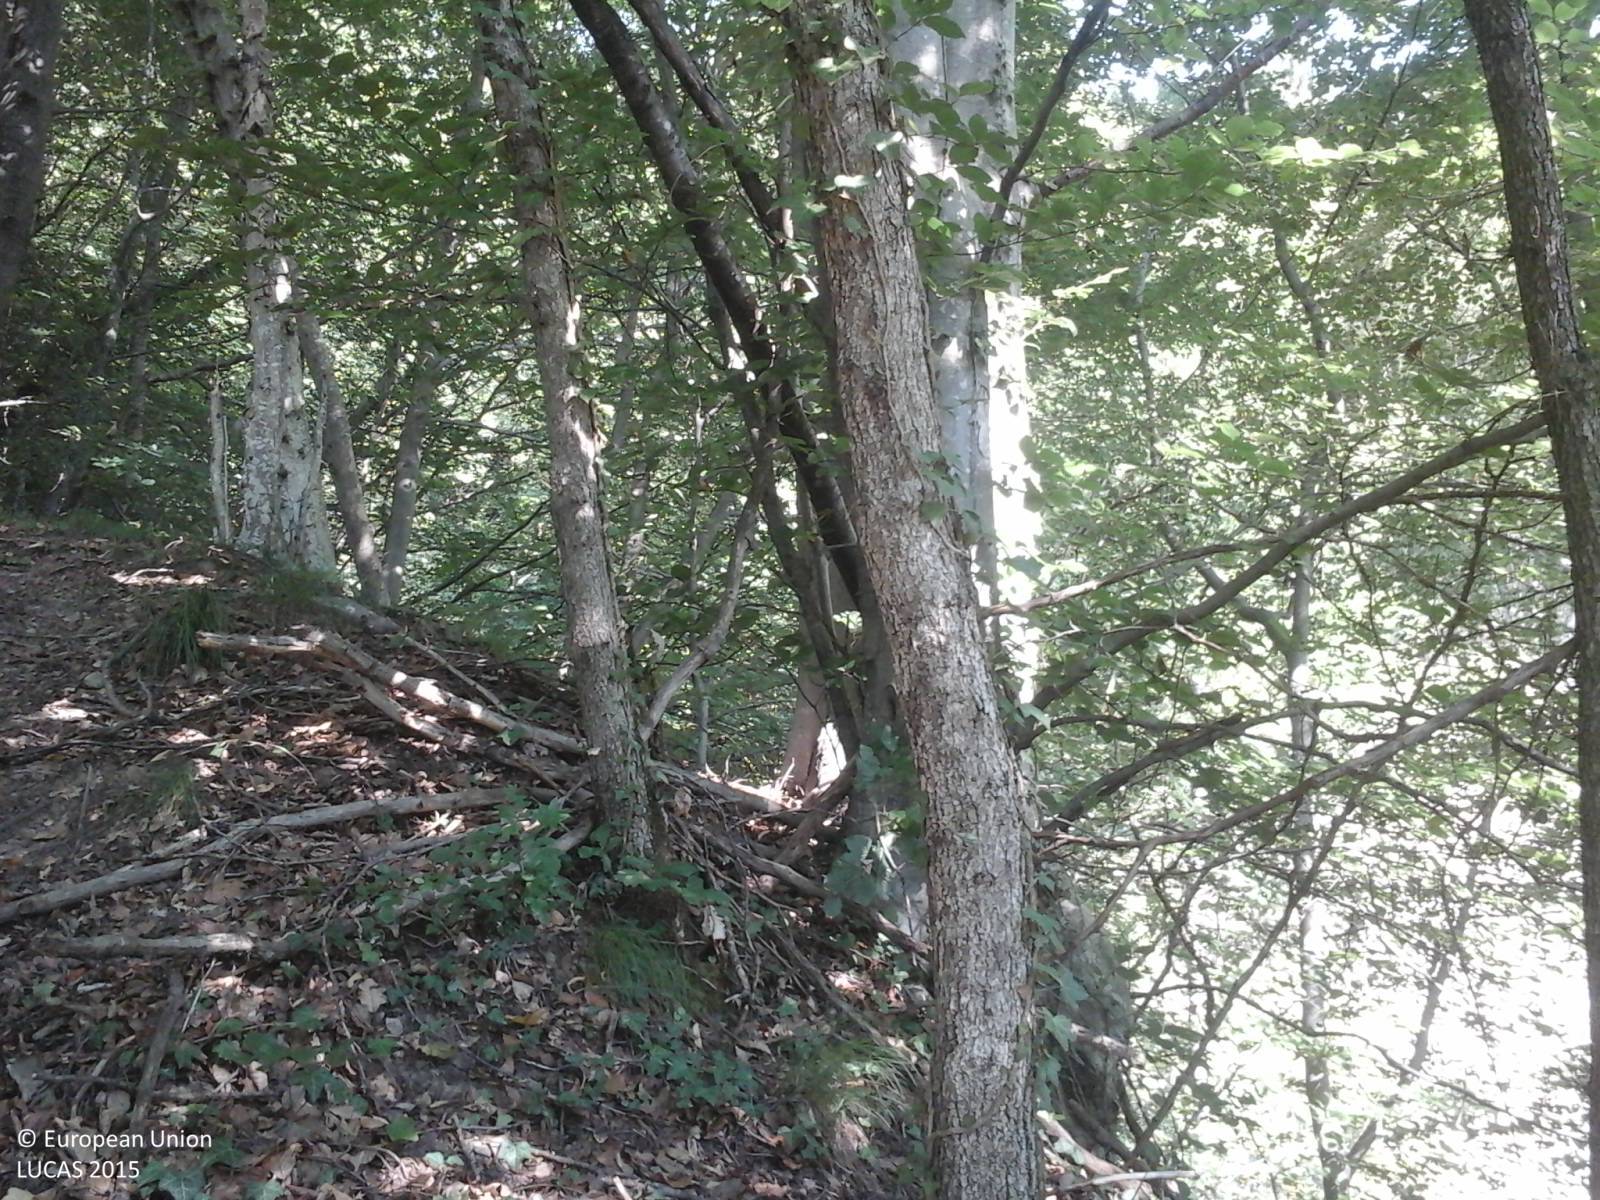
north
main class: Woodland
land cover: Broadleaved woodland
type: beech forest
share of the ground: > 75 %
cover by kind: broadleaved forest trees 80 %, coniferous forest trees 20 %
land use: Forestry
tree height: > 5 m
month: September
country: IT
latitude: 46.4697
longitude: 13.0574
